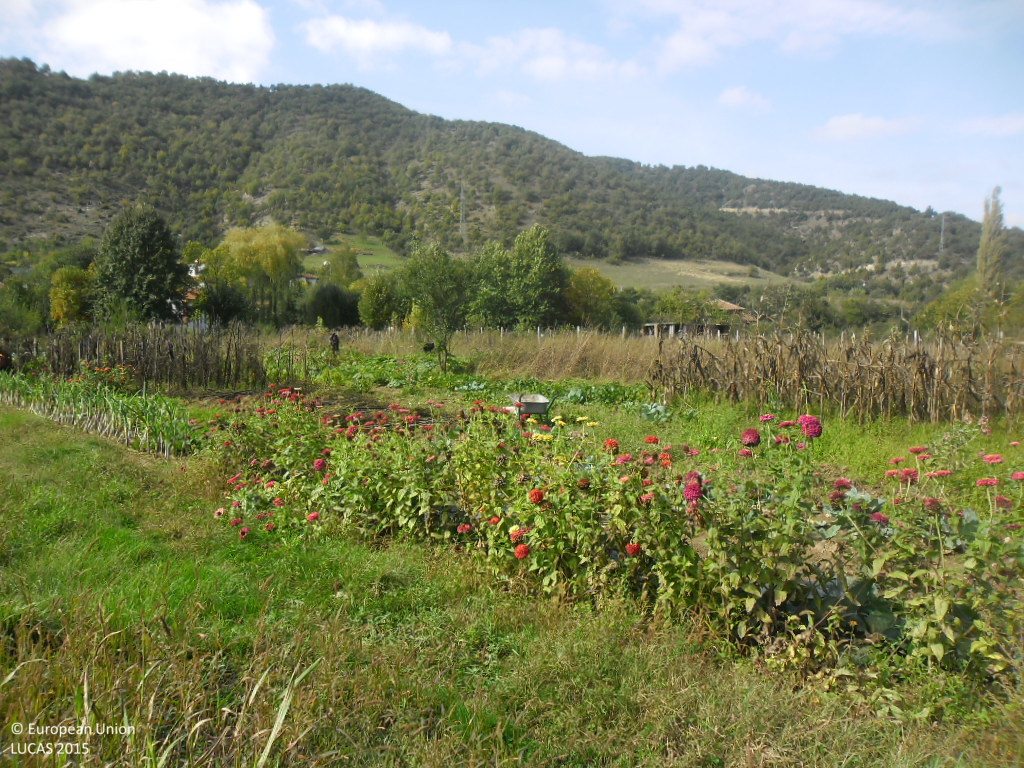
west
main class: Grassland
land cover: Spontaneously vegetated surfaces
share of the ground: > 75 %
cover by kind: herbaceous plants 100 %
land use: Agriculture (excluding fallow land and kitchen gardens)
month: October
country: BG
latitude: 41.9261
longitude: 23.1073
